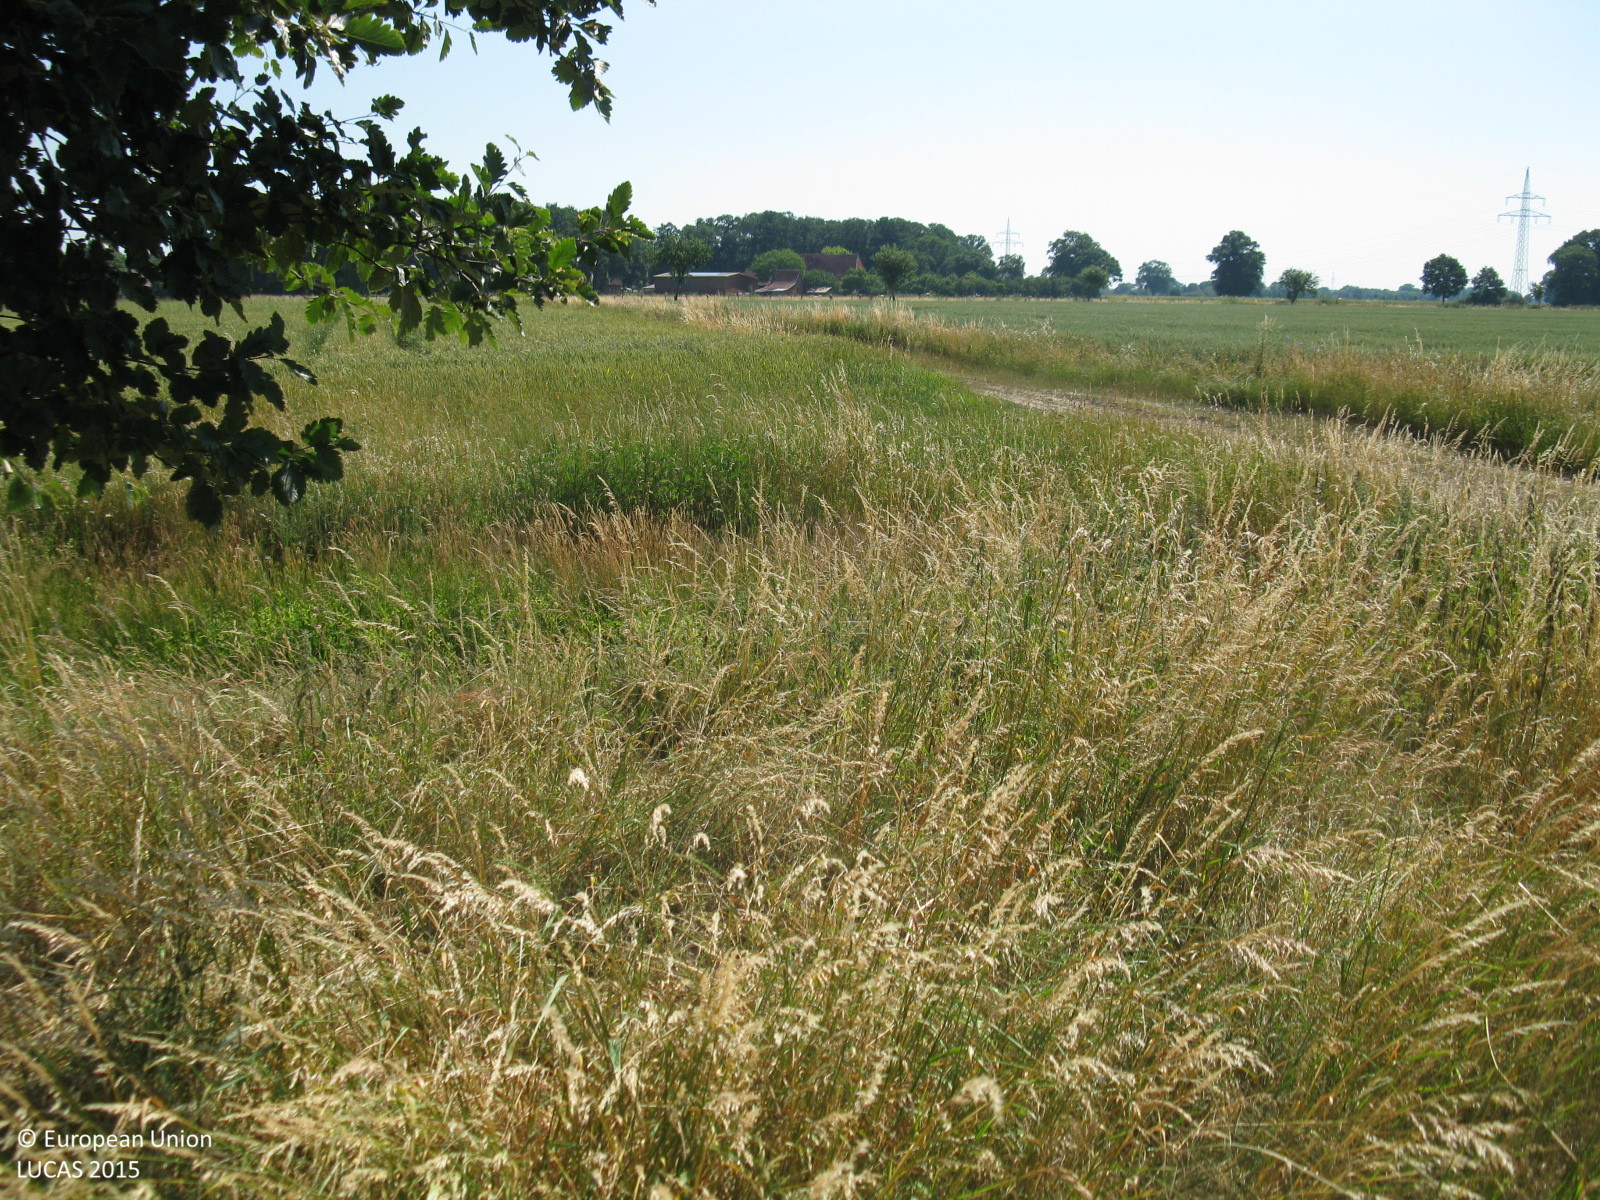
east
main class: Grassland
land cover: Grassland with sparse tree/shrub cover
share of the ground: > 75 %
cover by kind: herbaceous plants 95 %, broadleaved forest trees 5 %
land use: Agriculture (excluding fallow land and kitchen gardens)
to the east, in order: Grassland with sparse tree/shrub cover; Ditches and canals; Grassland without tree/shrub cover; Common wheat; Grass margins; Tracks; Grass margins; Common wheat; Lines of trees; Paved roads, cycling and walking lanes; Grassland without tree/shrub cover; Fences; Grassland without tree/shrub cover
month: July
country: DE
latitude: 52.8413
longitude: 9.0947
